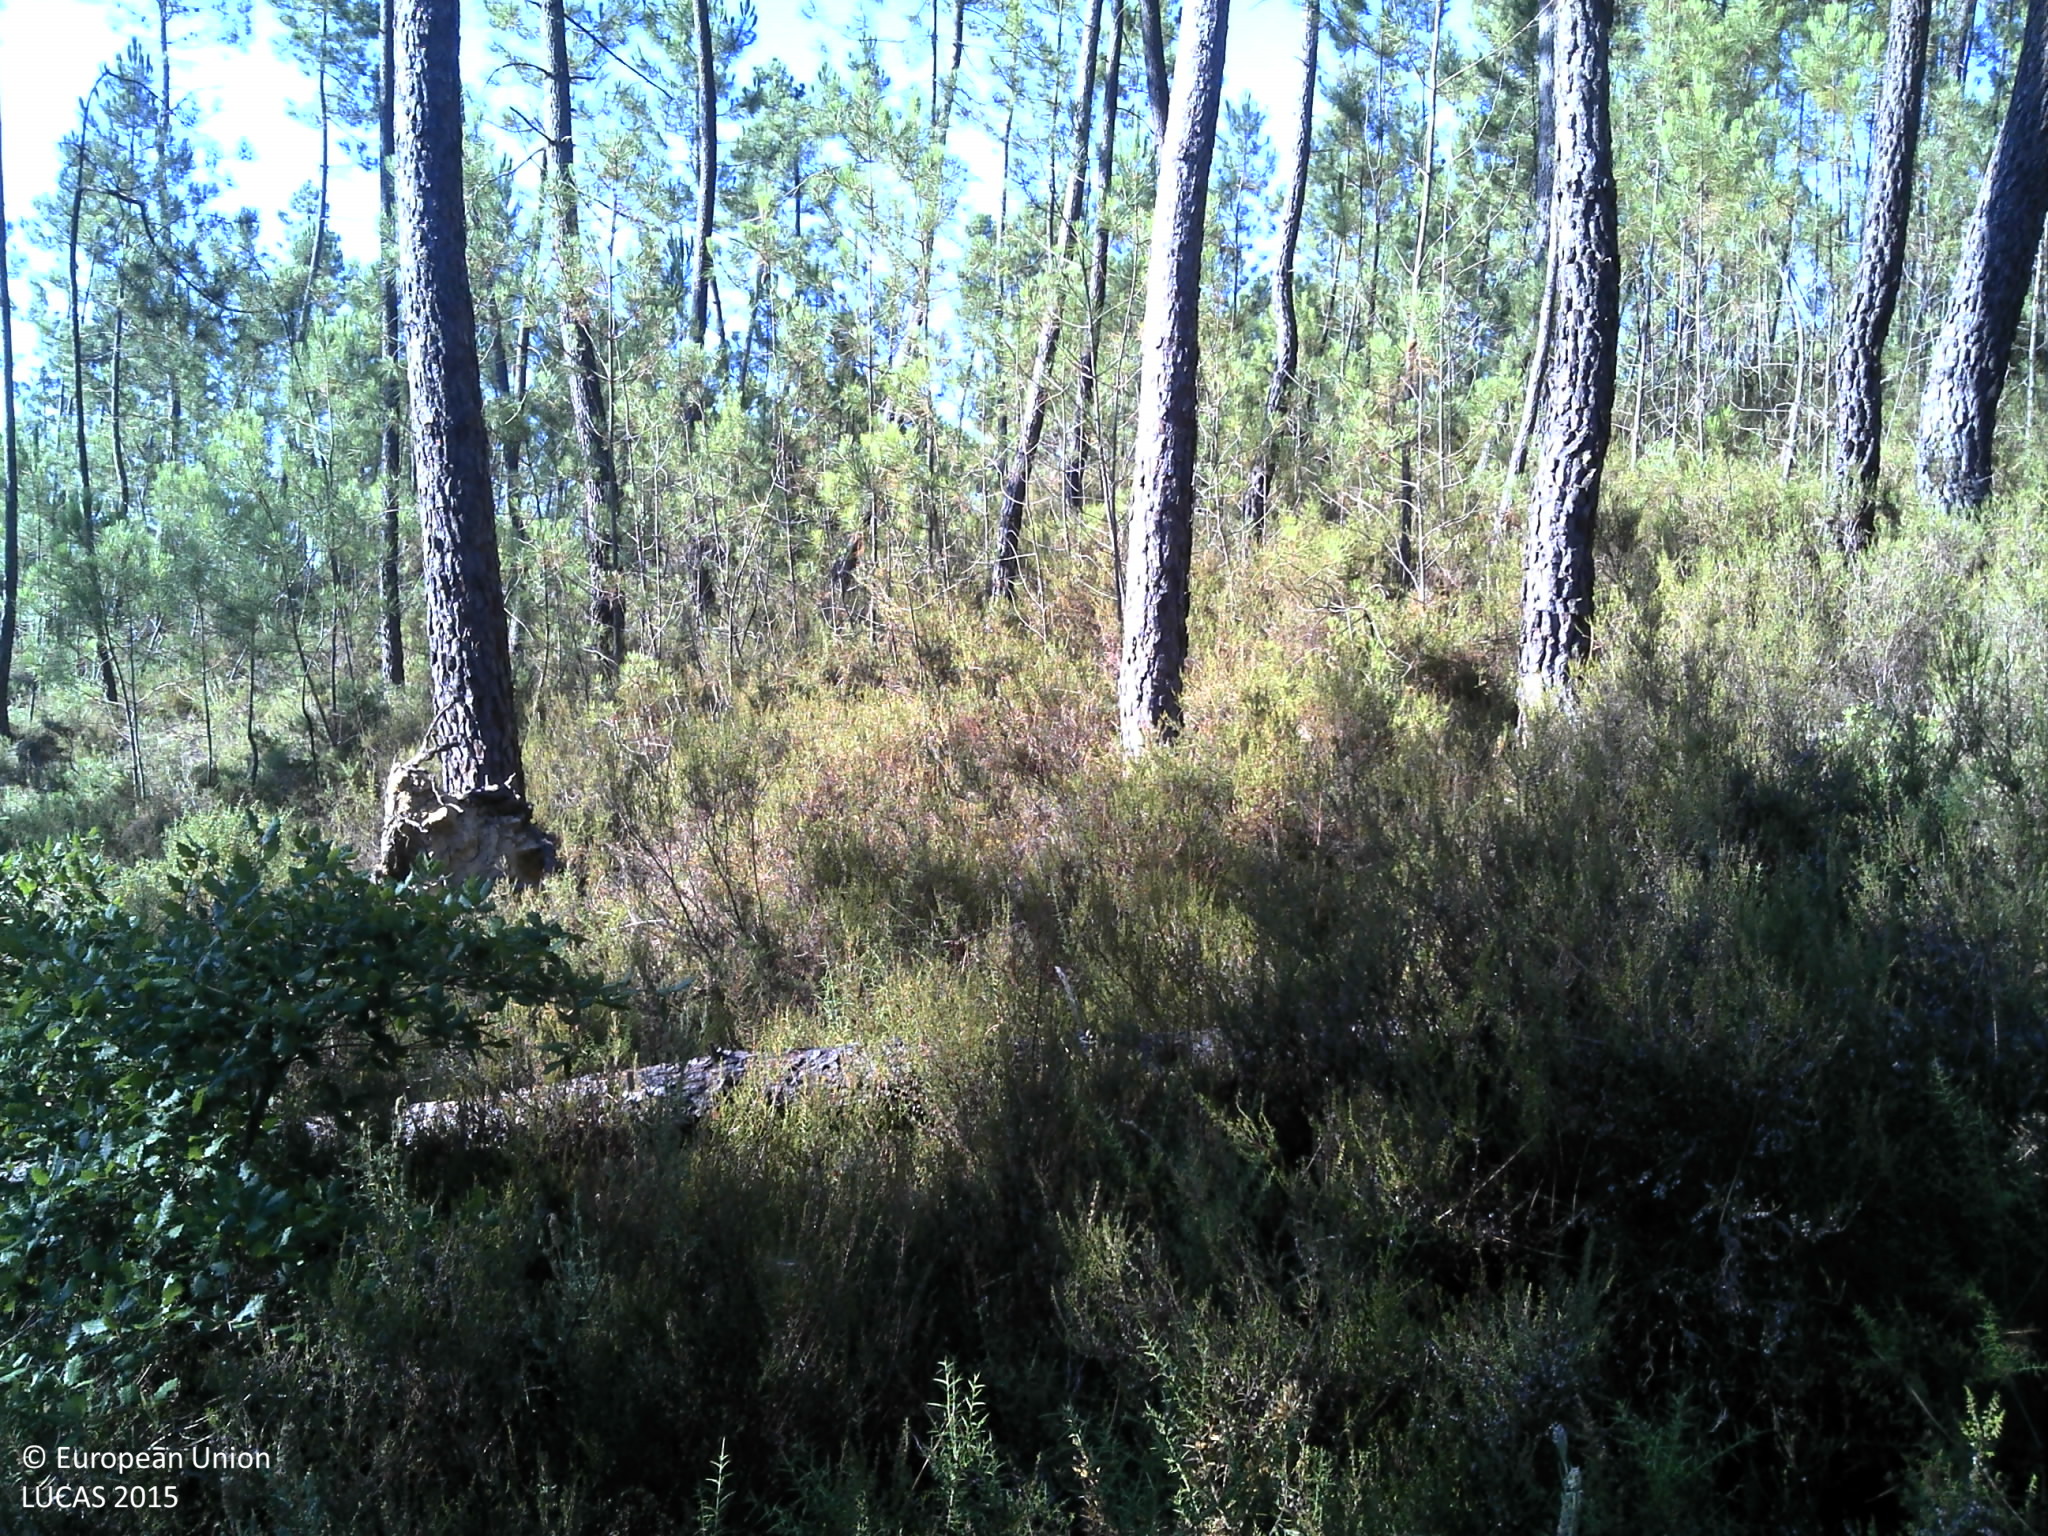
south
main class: Woodland
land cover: Pine dominated coniferous woodland
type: coniferous forest of the mediterranean region
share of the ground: 25 - 50 %
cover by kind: shrubs 75 %, coniferous forest trees 25 %
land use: Forestry
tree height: > 5 m
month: July
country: PT
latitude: 39.7646
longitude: -8.1259
